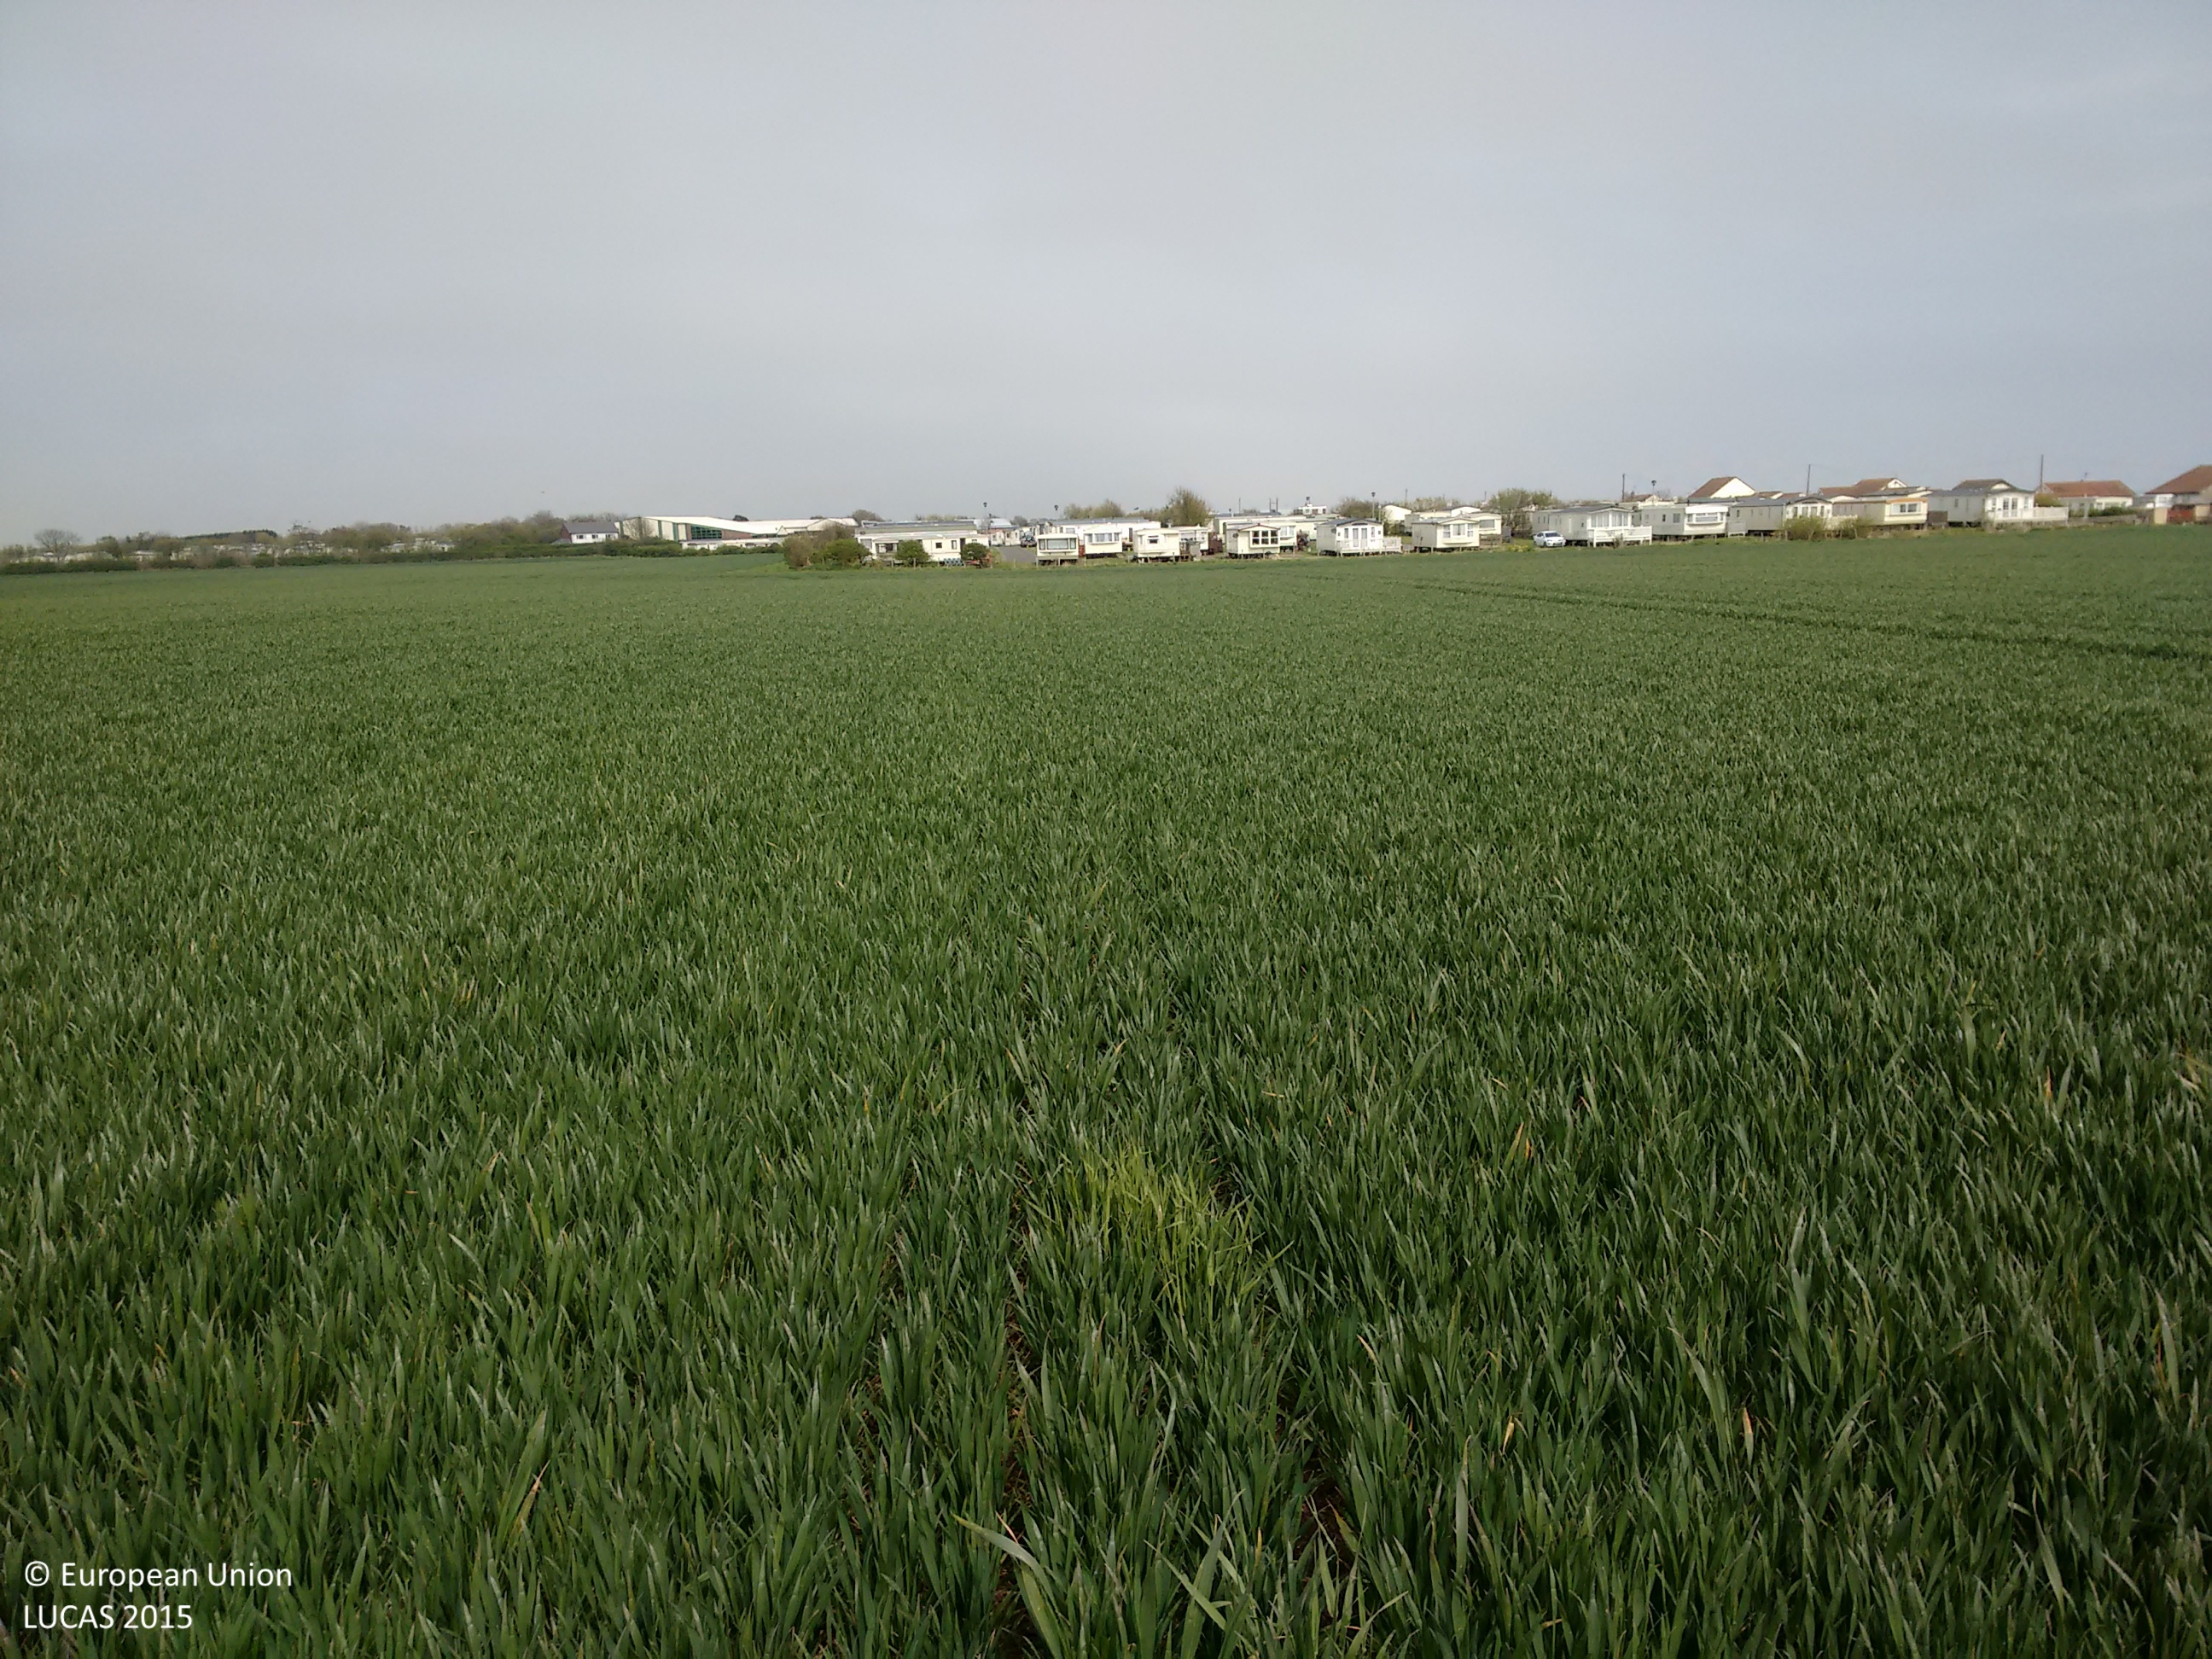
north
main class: Cropland
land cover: Common wheat
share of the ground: > 75 %
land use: Agriculture (excluding fallow land and kitchen gardens)
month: May
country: GB
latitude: 53.9848
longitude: -0.2051
